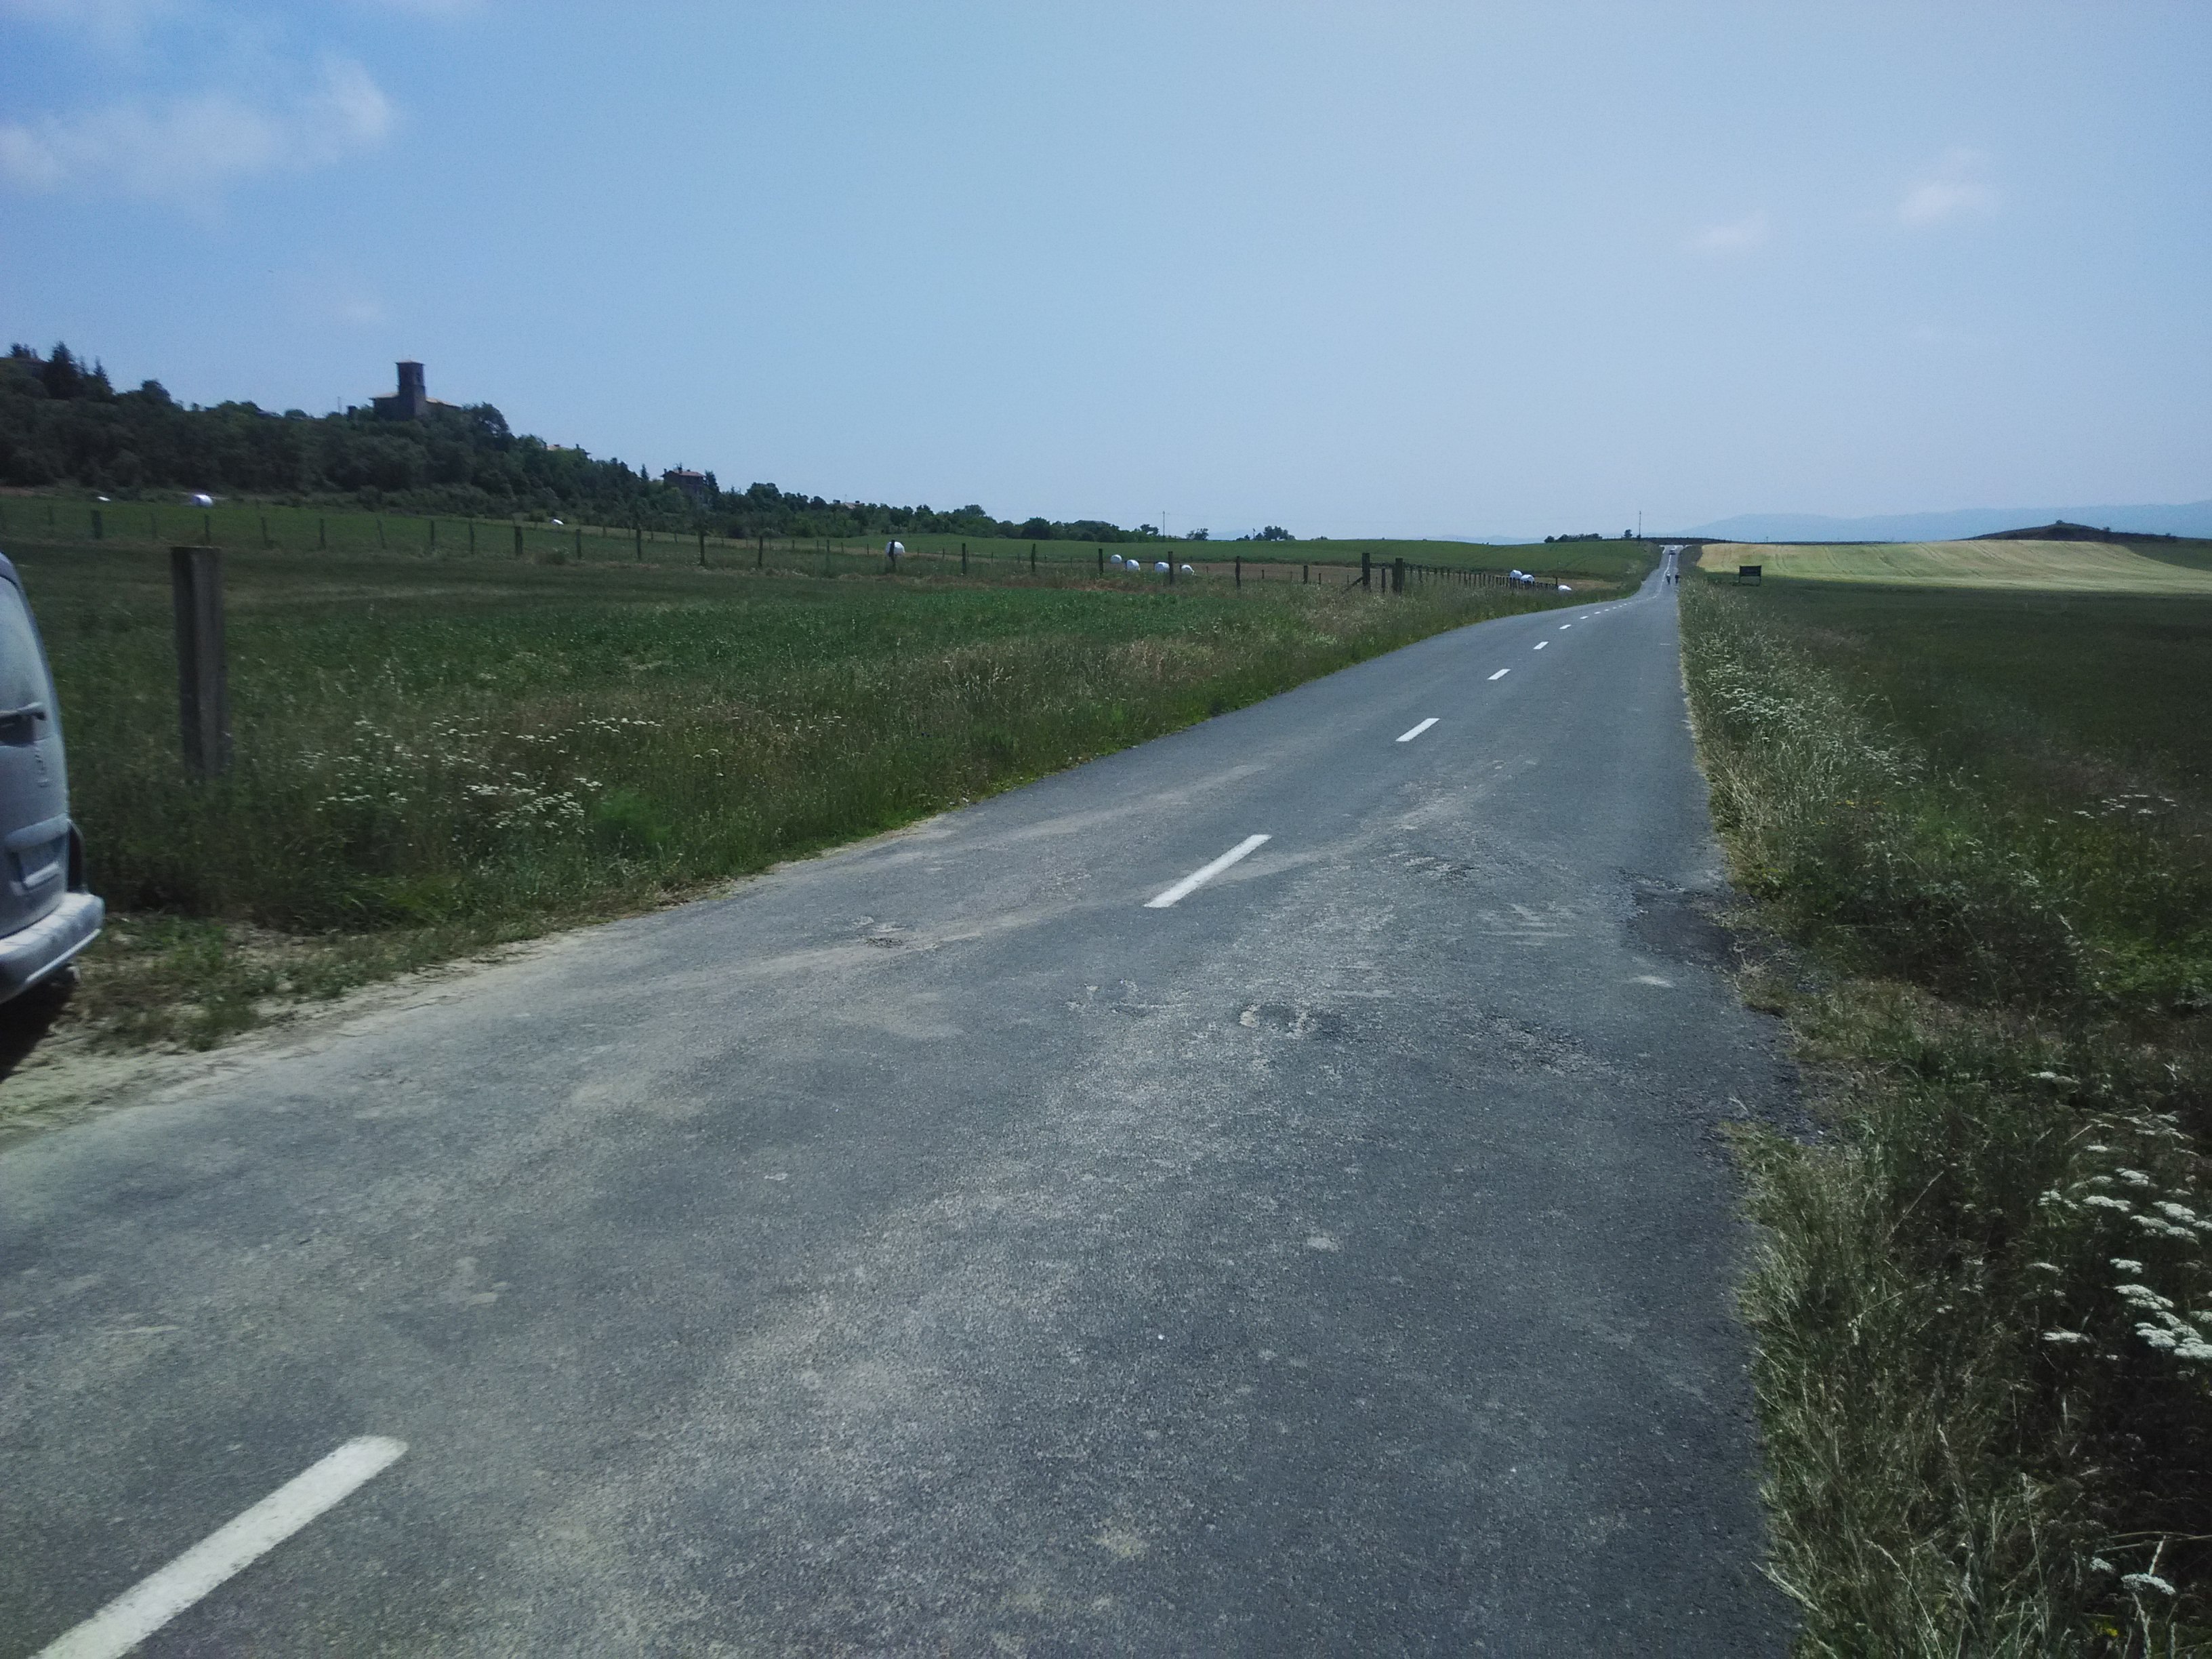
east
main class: Cropland
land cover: Common wheat
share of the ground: > 75 %
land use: Agriculture (excluding fallow land and kitchen gardens)
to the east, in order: Common wheat; Grass margins; Common wheat
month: June
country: ES
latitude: 42.8948
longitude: -2.5285
